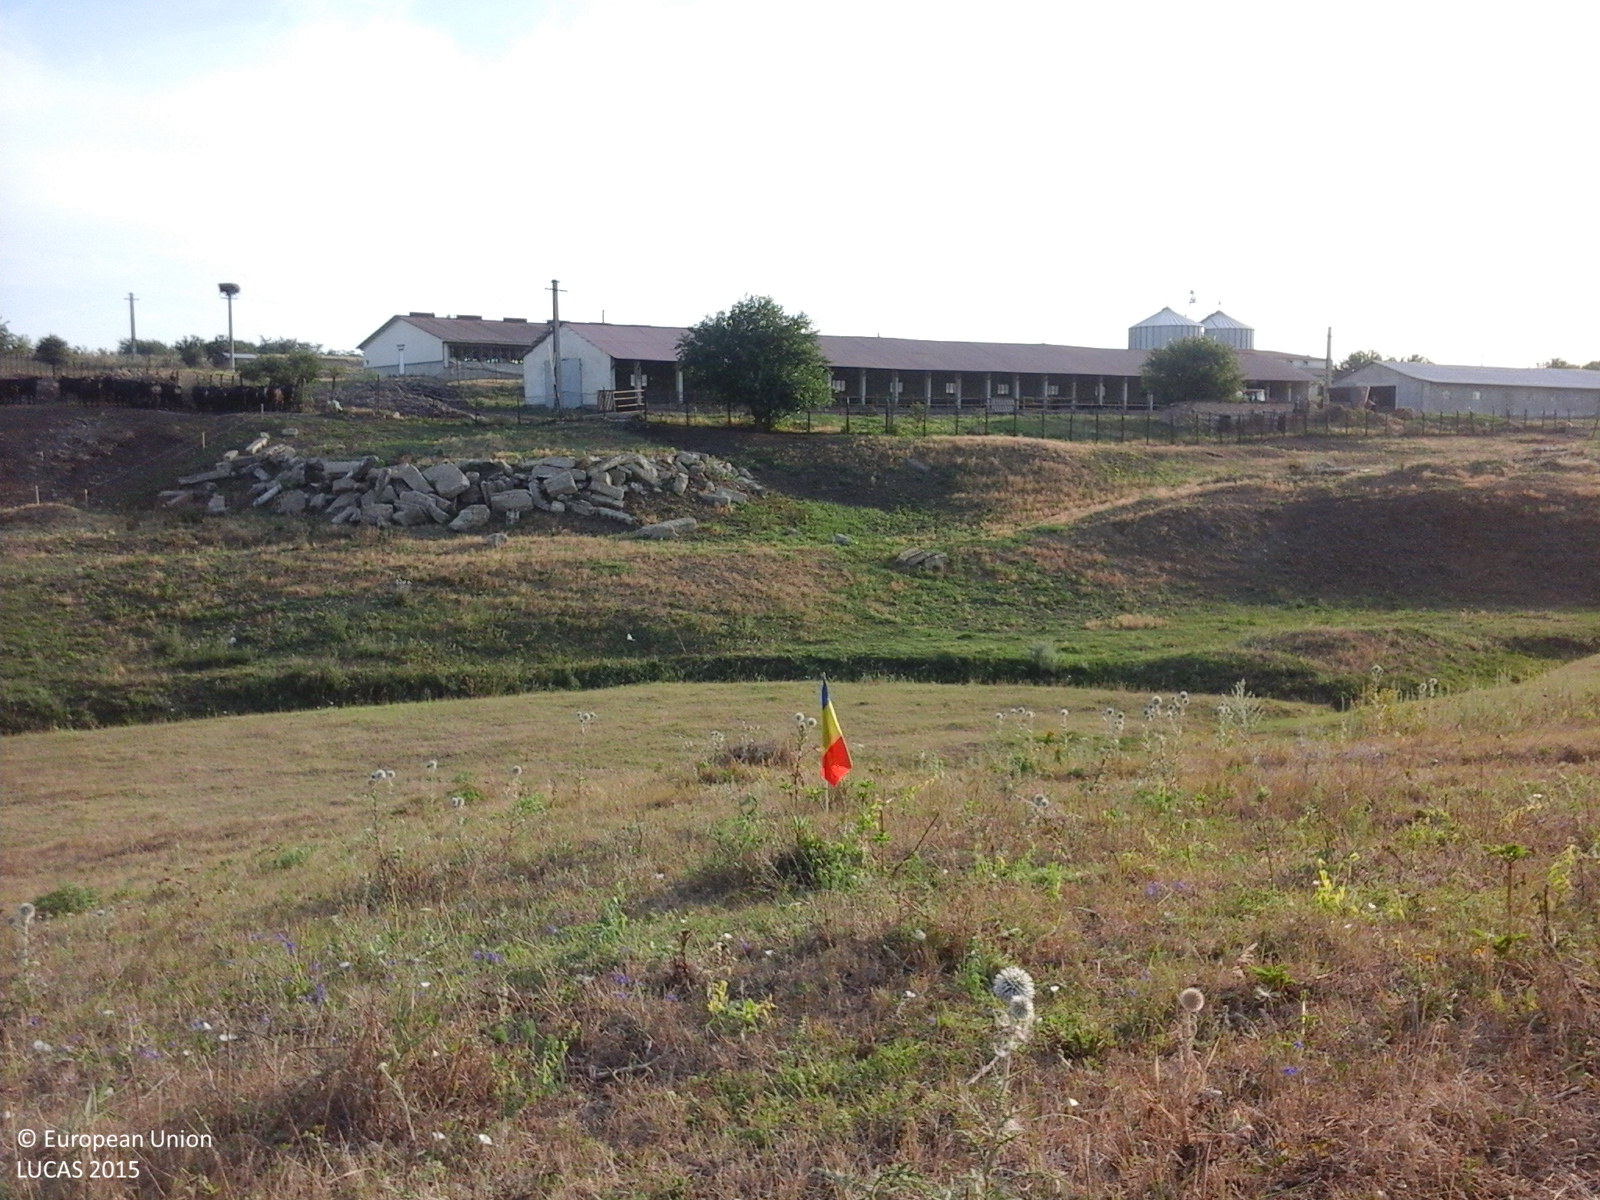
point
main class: Grassland
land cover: Grassland without tree/shrub cover
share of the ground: > 75 %
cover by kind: herbaceous plants 100 %
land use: Agriculture (excluding fallow land and kitchen gardens)
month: July
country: RO
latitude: 46.1876
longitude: 28.0170
